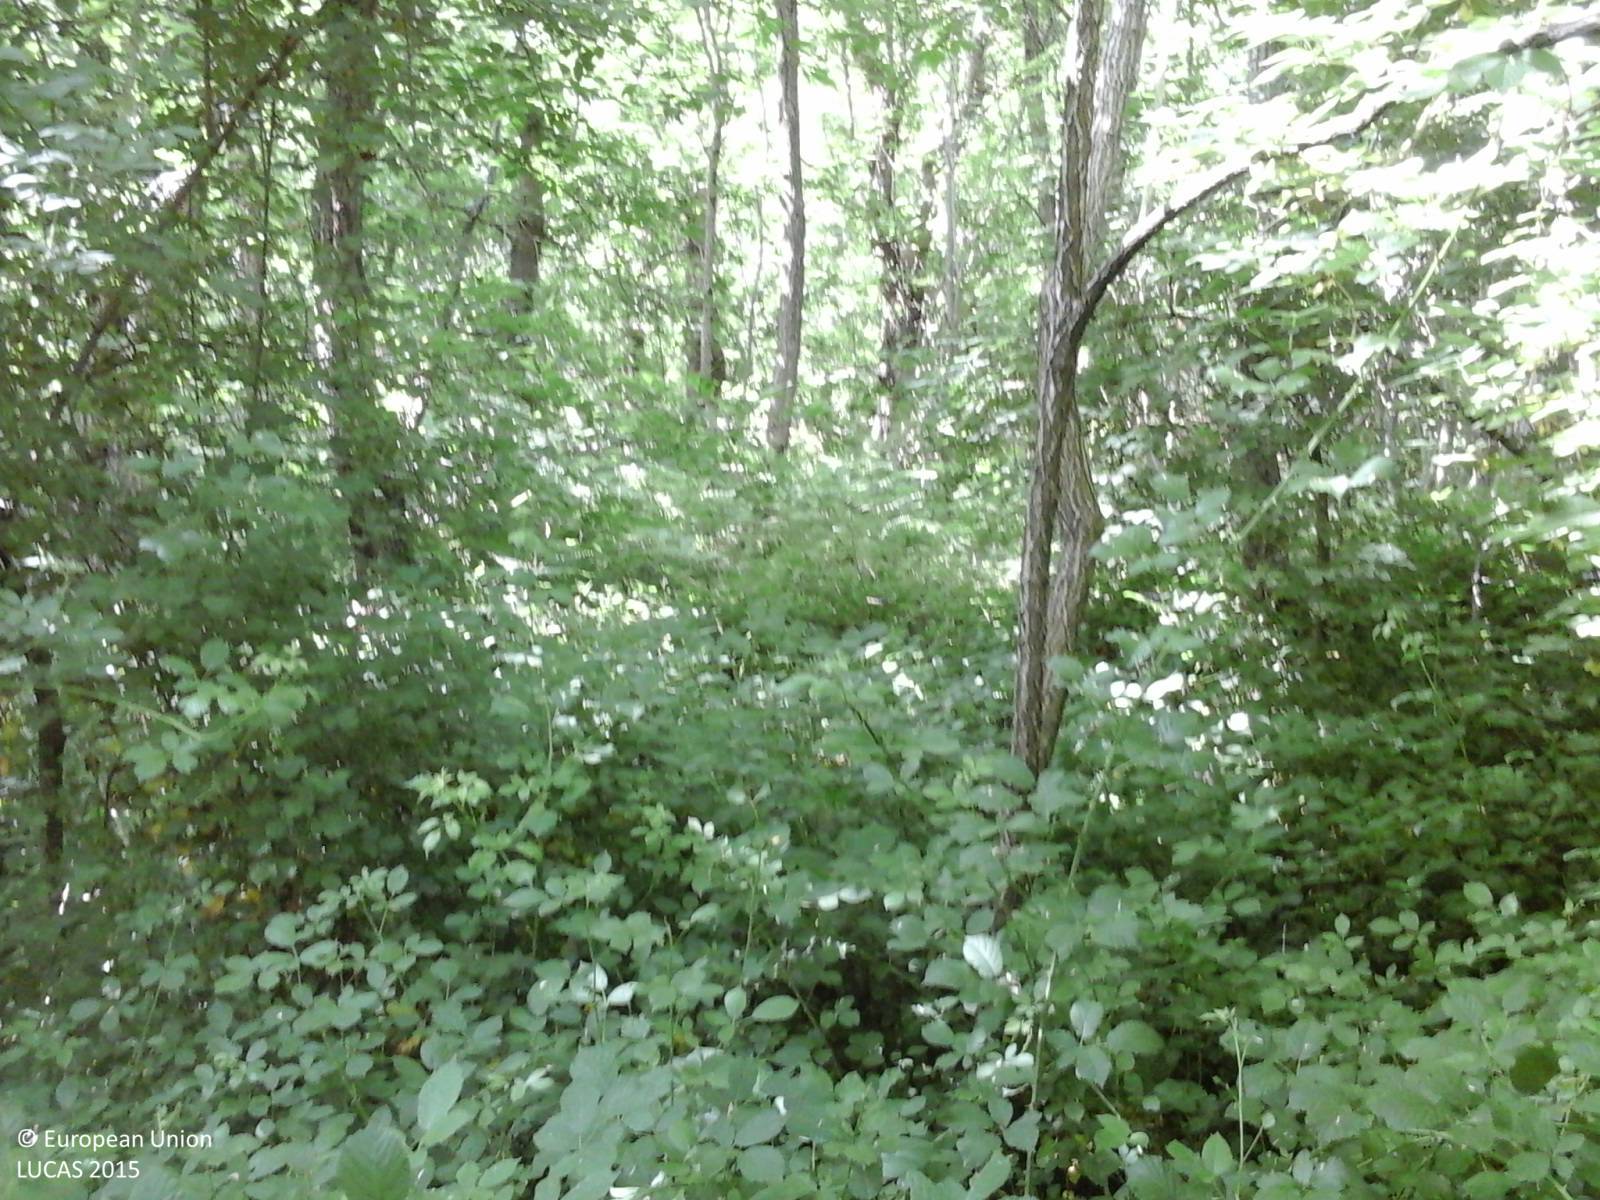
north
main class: Woodland
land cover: Broadleaved woodland
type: thermophilous deciduous forest
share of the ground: > 75 %
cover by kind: broadleaved forest trees 100 %
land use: Forestry
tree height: > 5 m
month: June
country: IT
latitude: 44.1699
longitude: 10.2370
